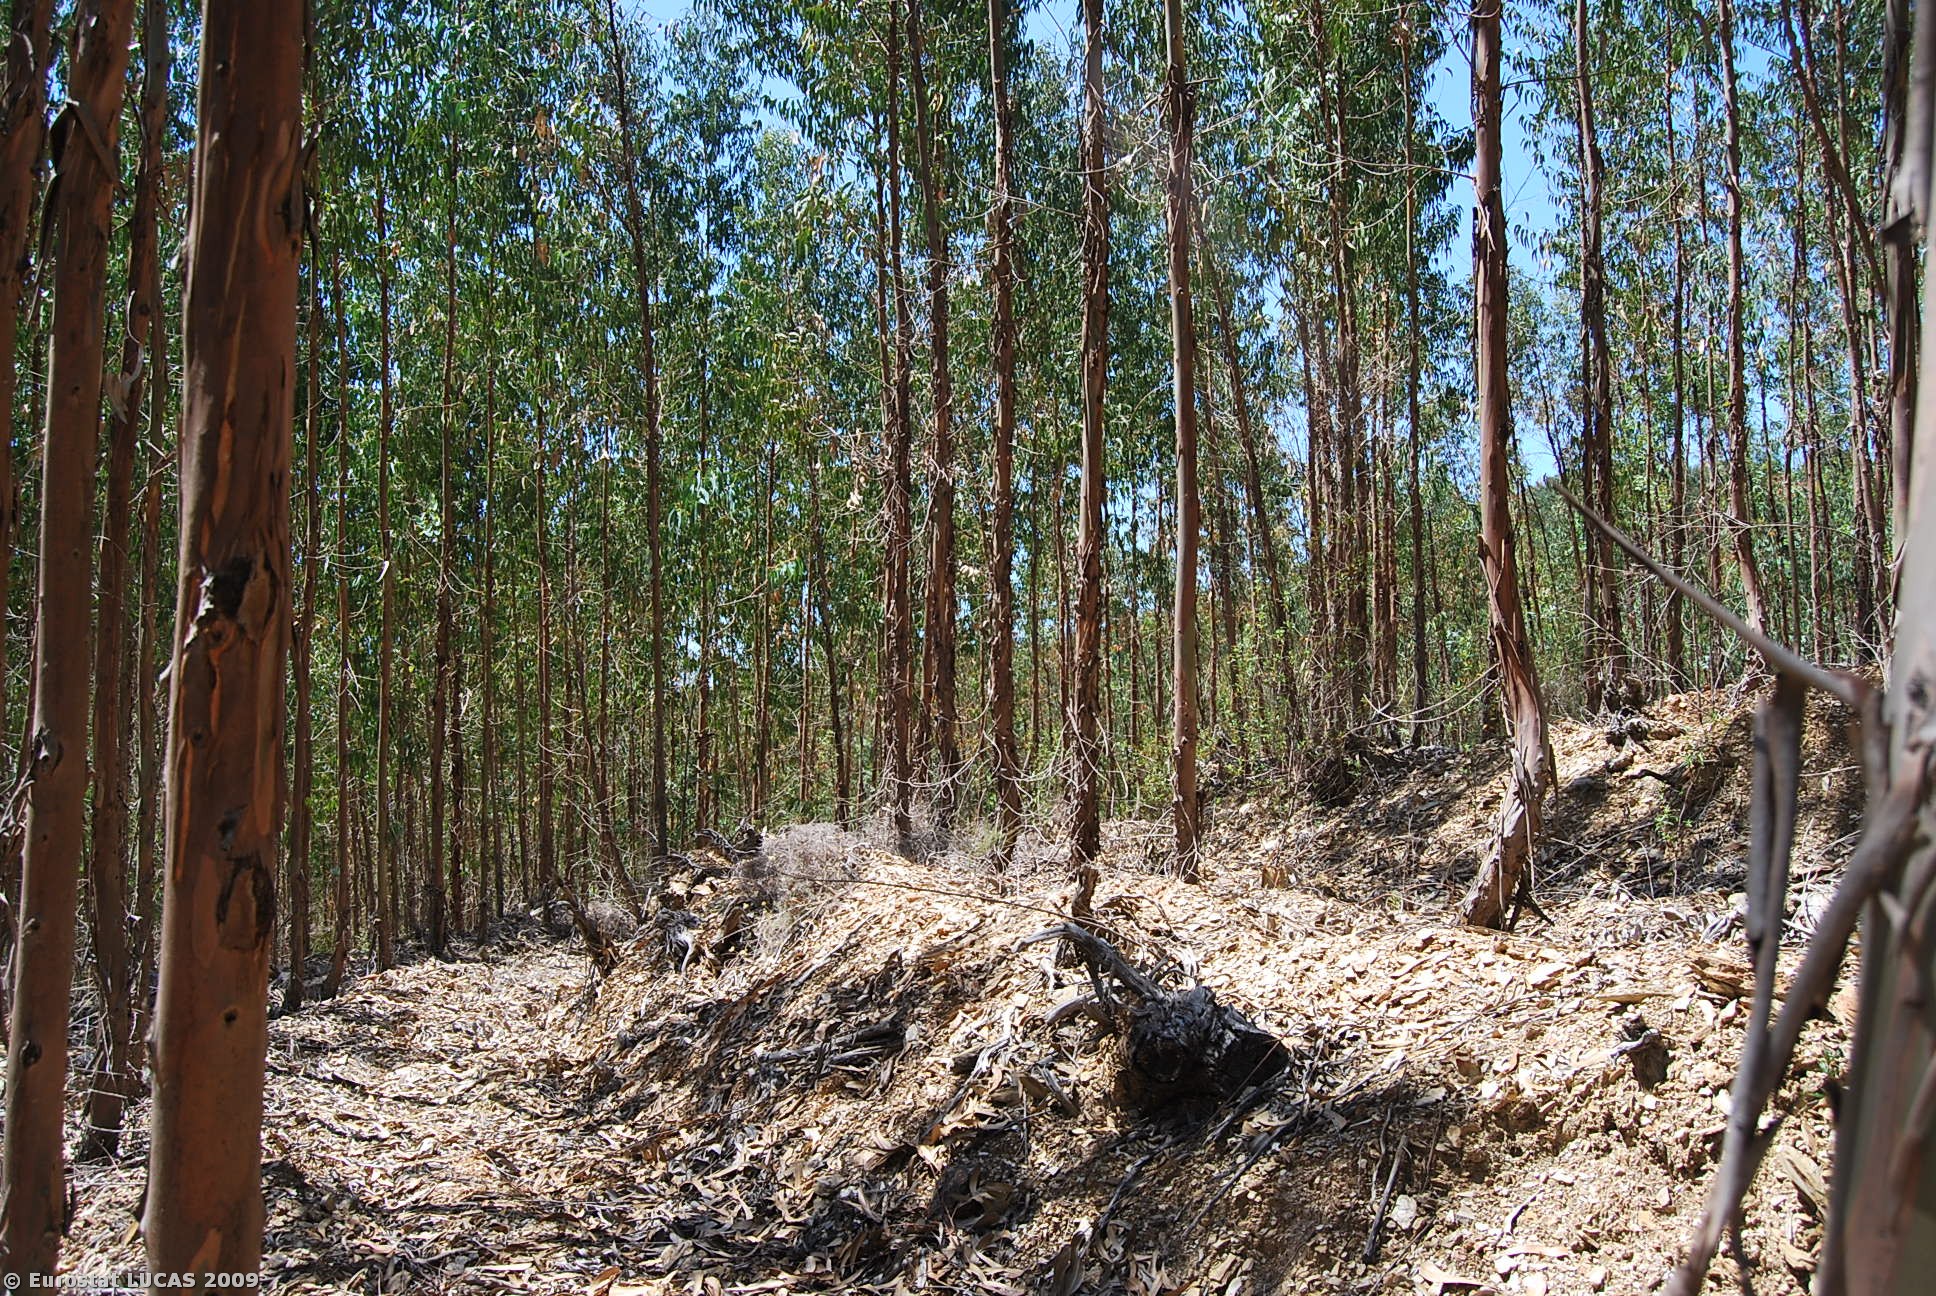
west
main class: Woodland
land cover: Broadleaved woodland
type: plantations and self-sown exotic forest
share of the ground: 50 - 75 %
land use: Forestry
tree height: > 5 m
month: July
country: PT
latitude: 37.6790
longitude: -8.4839
